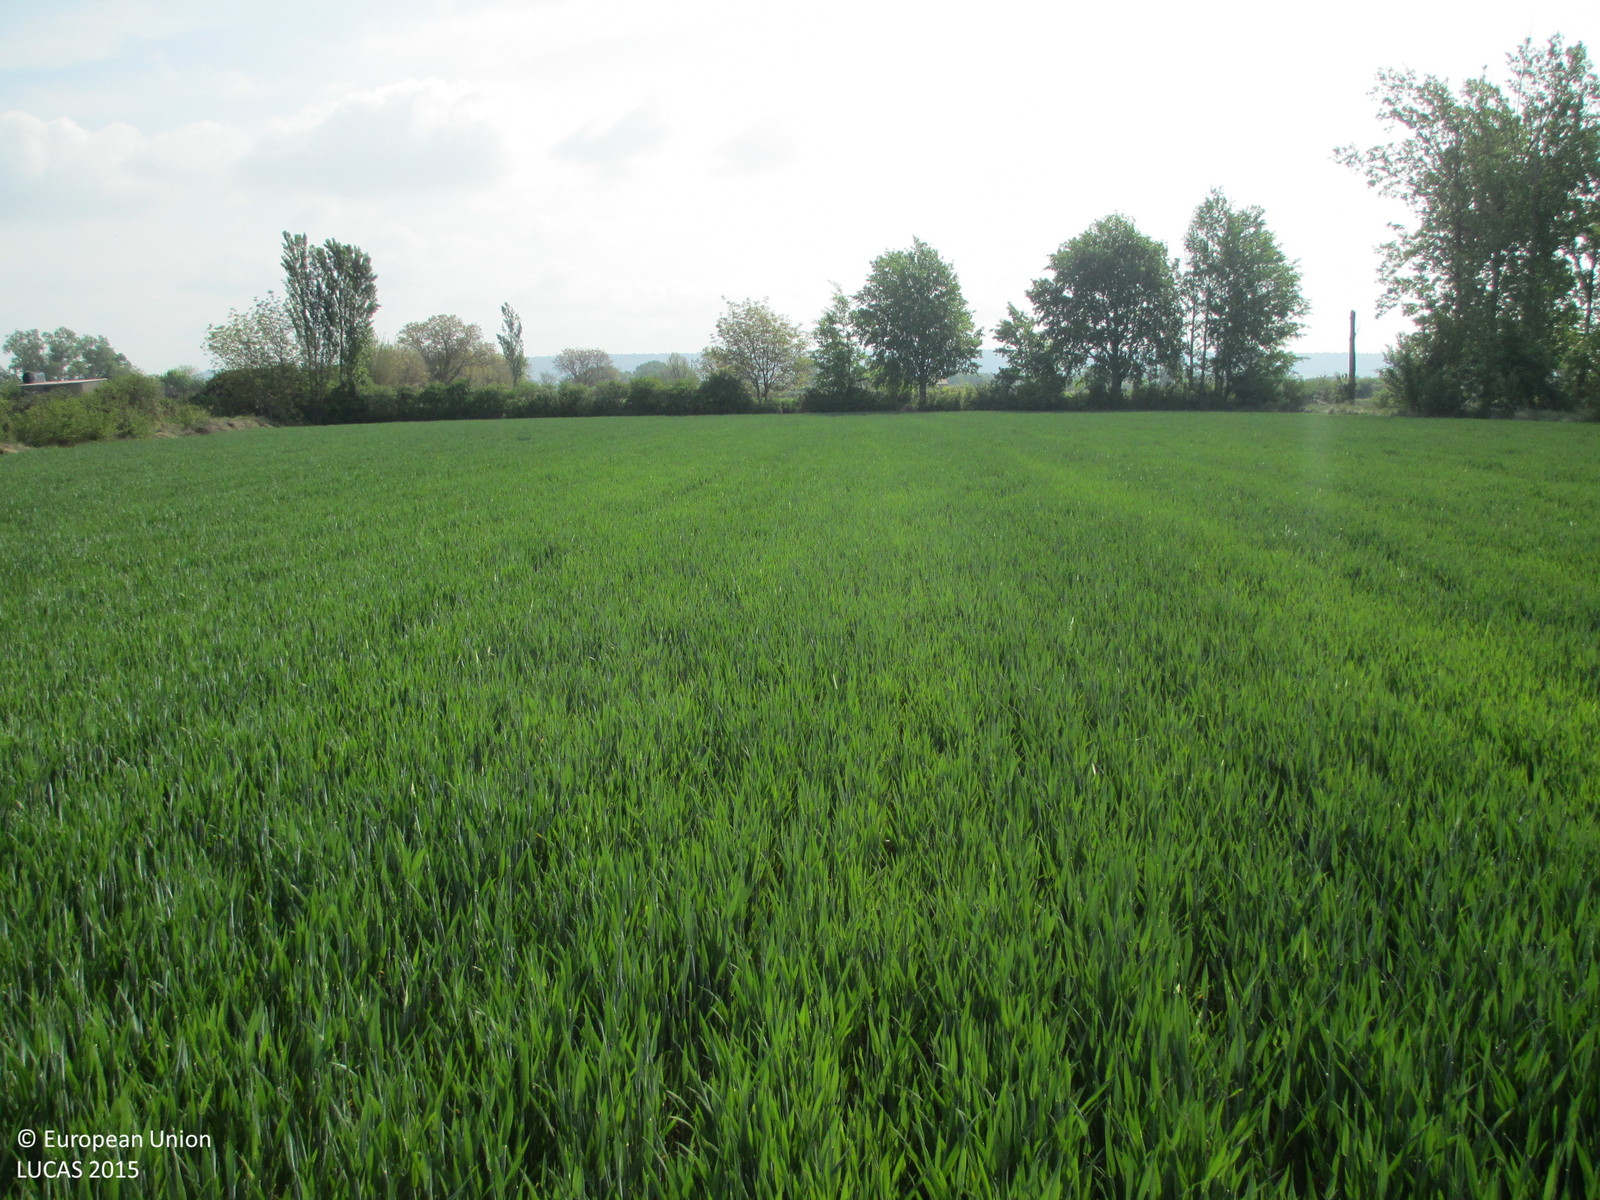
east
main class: Cropland
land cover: Durum wheat
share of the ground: > 75 %
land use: Agriculture (excluding fallow land and kitchen gardens)
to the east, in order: Durum wheat; Single bushes/trees; Ditches and canals; Single bushes/trees; Lucerne; Grass margins; Ditches and canals; Grass margins; Lucerne; Shruby margins; Tracks; Shruby margins
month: April
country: ES
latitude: 42.1185
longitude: -0.3879
